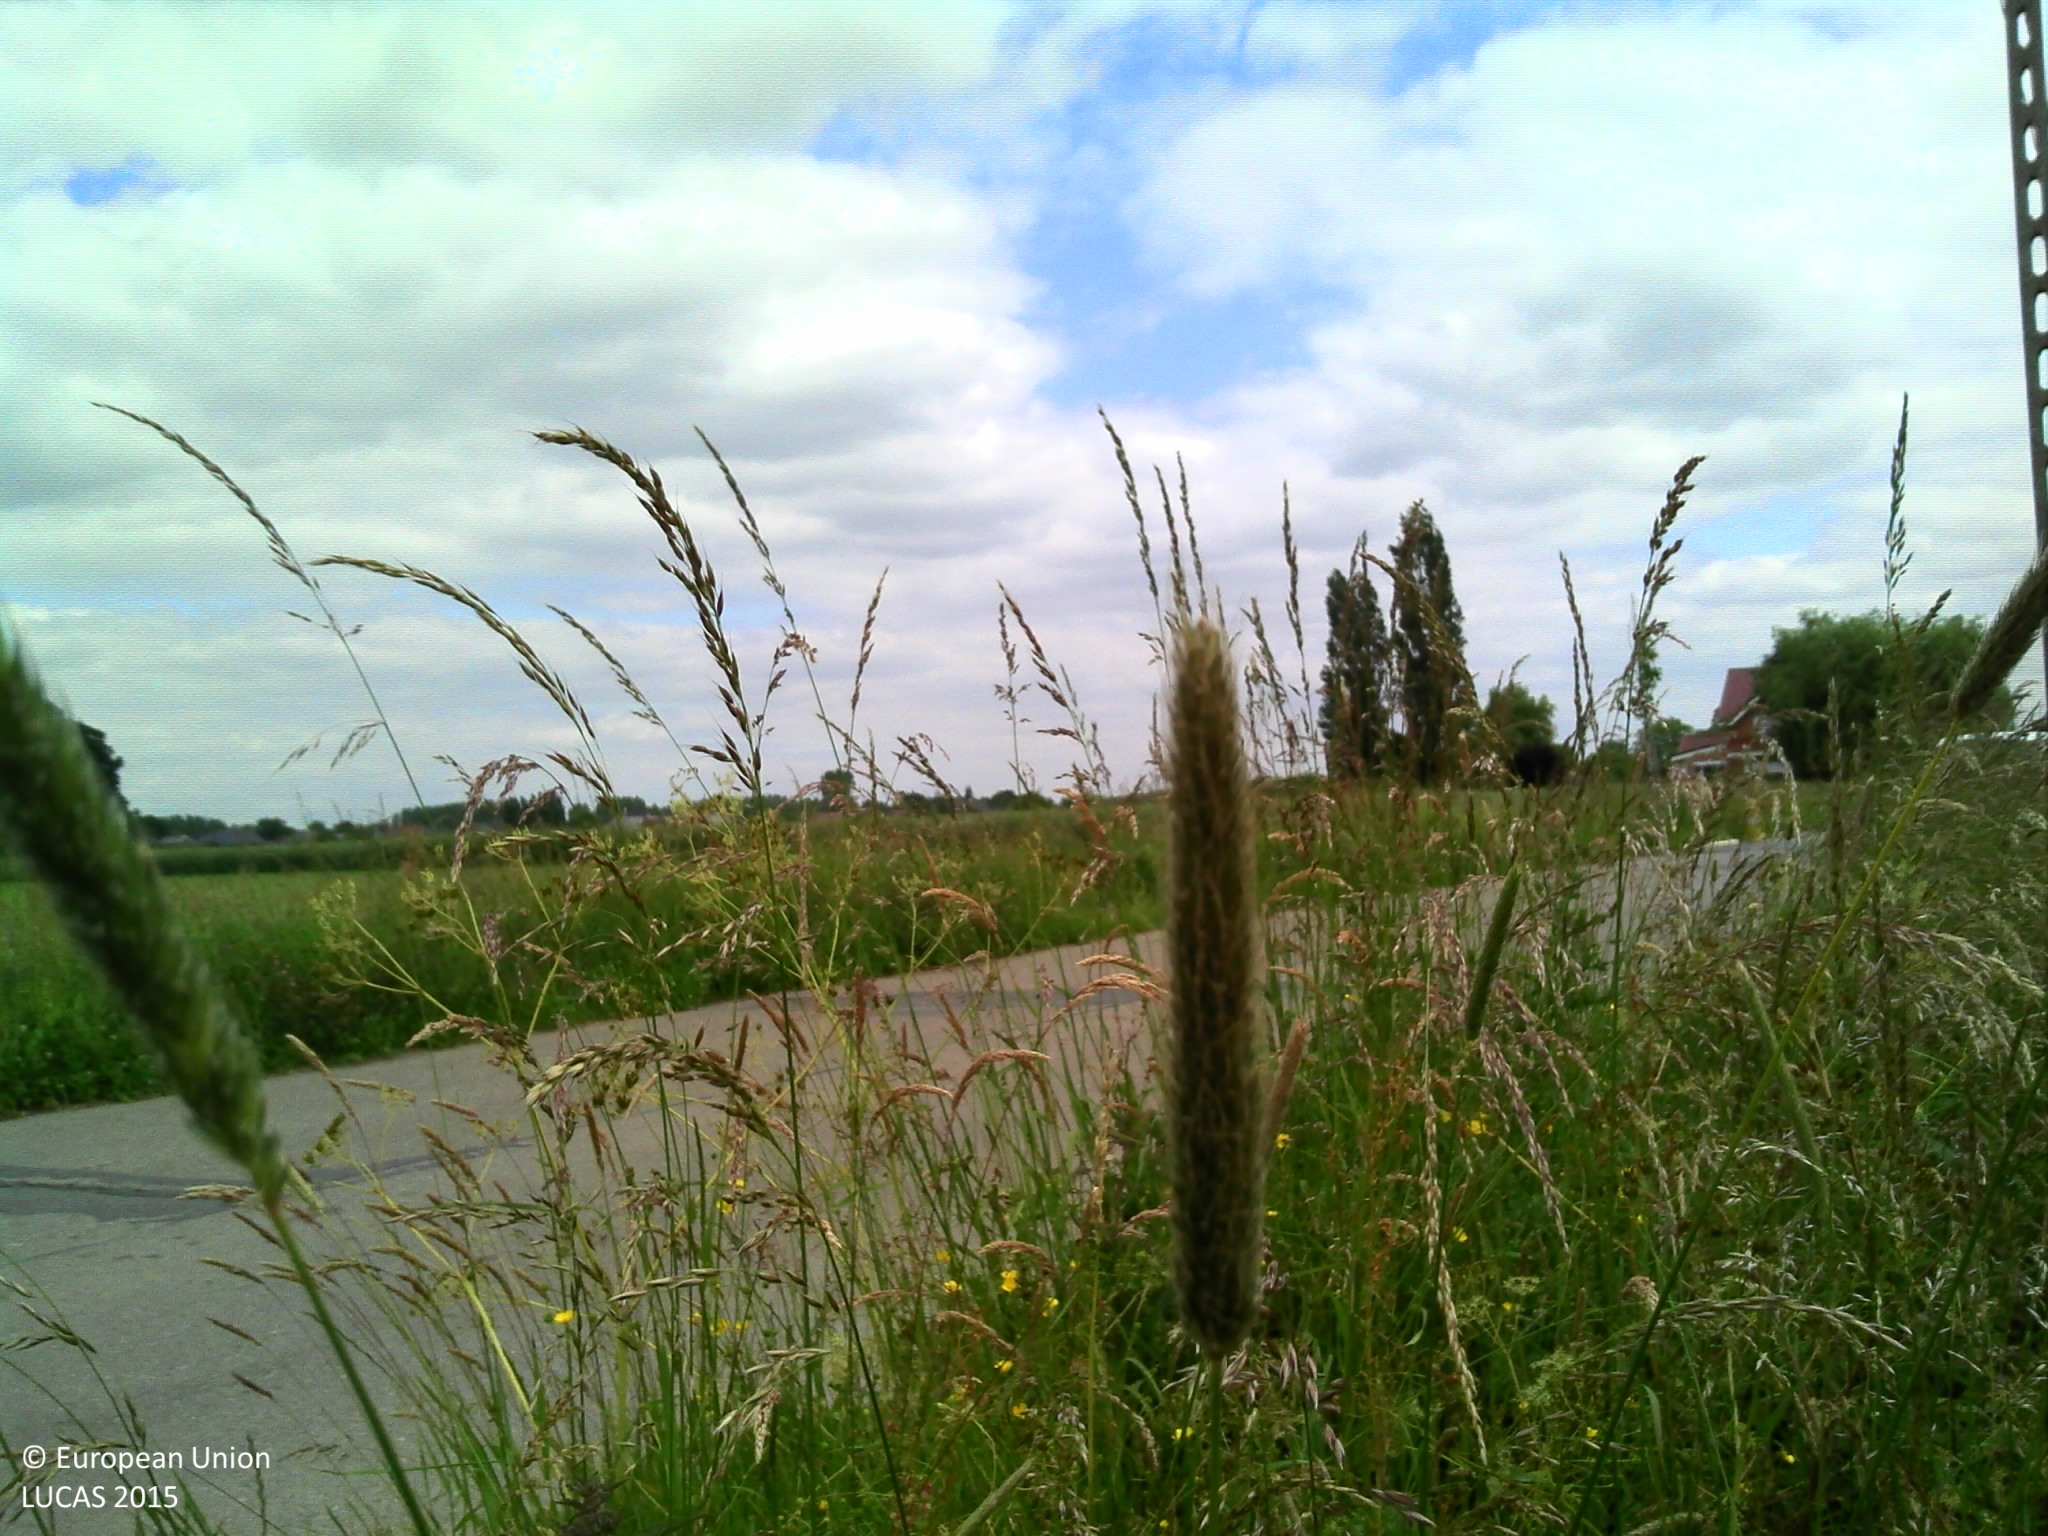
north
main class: Grassland
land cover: Grassland without tree/shrub cover
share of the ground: > 75 %
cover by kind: herbaceous plants 100 %
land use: Agriculture (excluding fallow land and kitchen gardens)
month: June
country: BE
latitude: 51.0011
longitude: 4.0234
